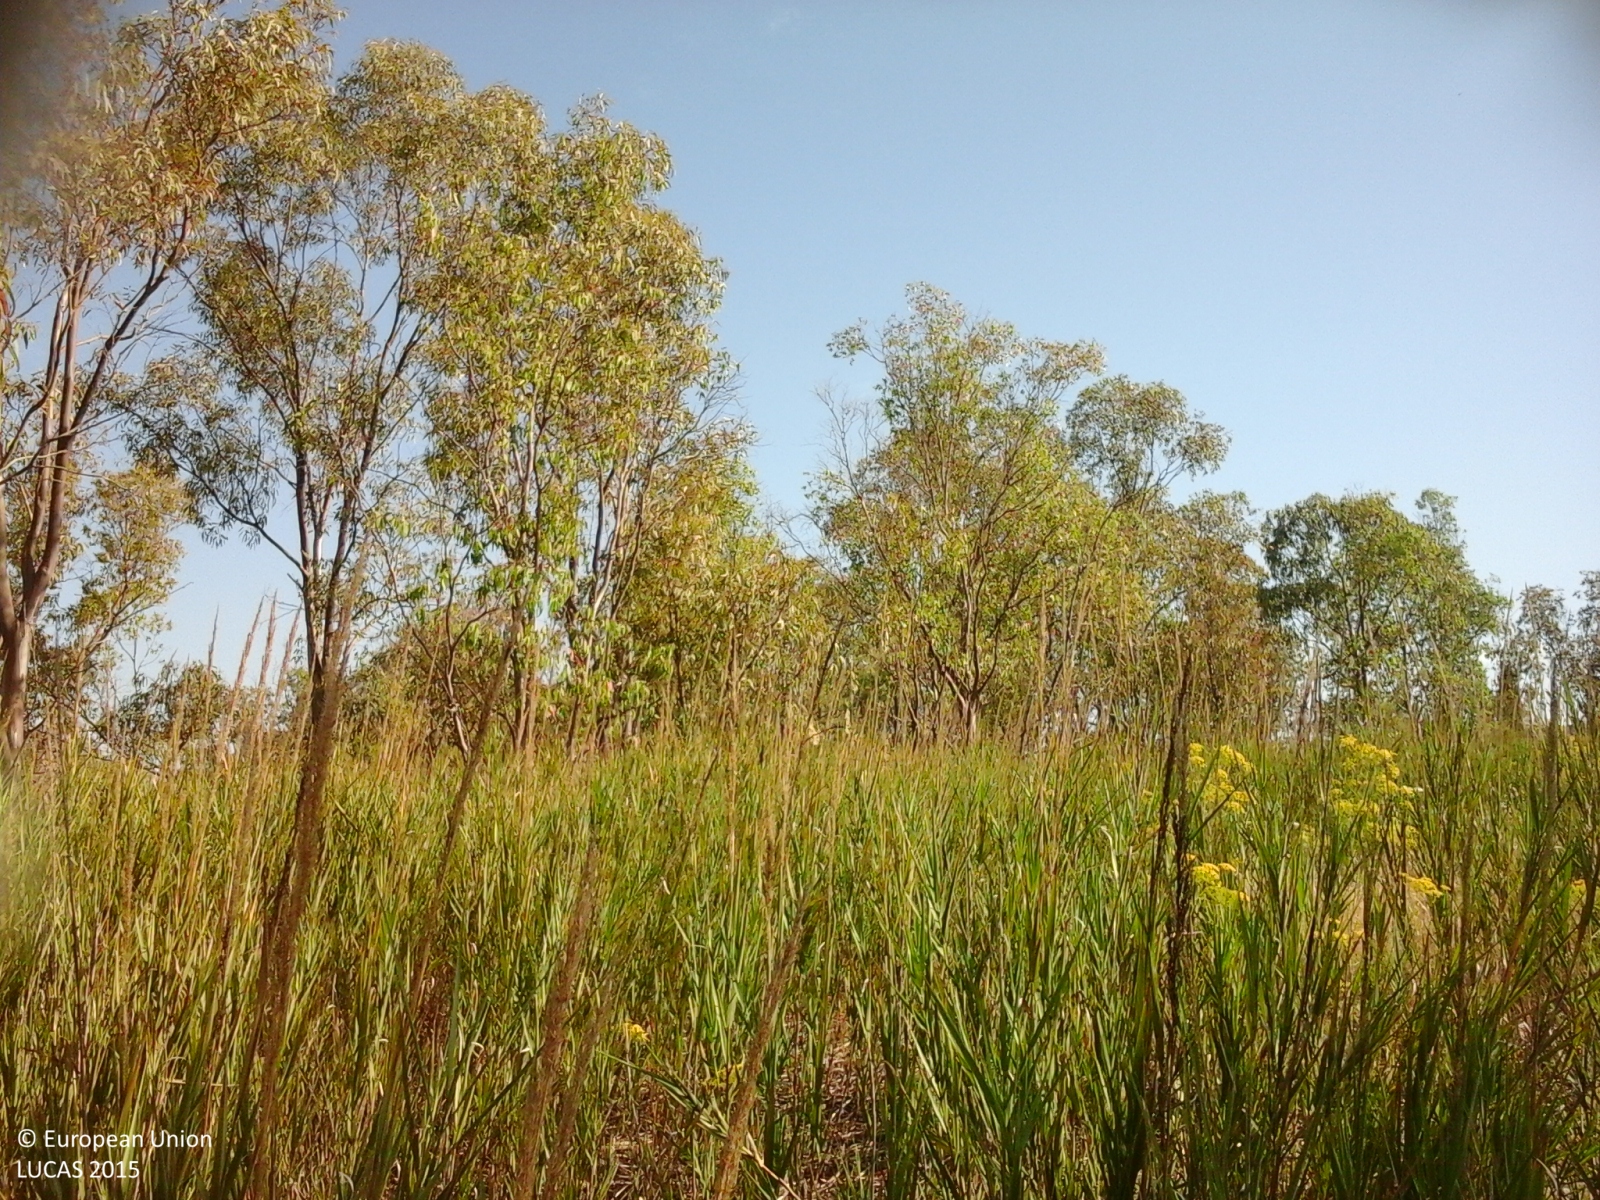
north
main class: Woodland
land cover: Broadleaved woodland
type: broadleaved evergreen forest
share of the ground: > 75 %
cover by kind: broadleaved forest trees 90 %, shrubs 5 %, herbaceous plants 5 %
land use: Forestry
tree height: > 5 m
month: June
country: IT
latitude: 37.4587
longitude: 13.6689
